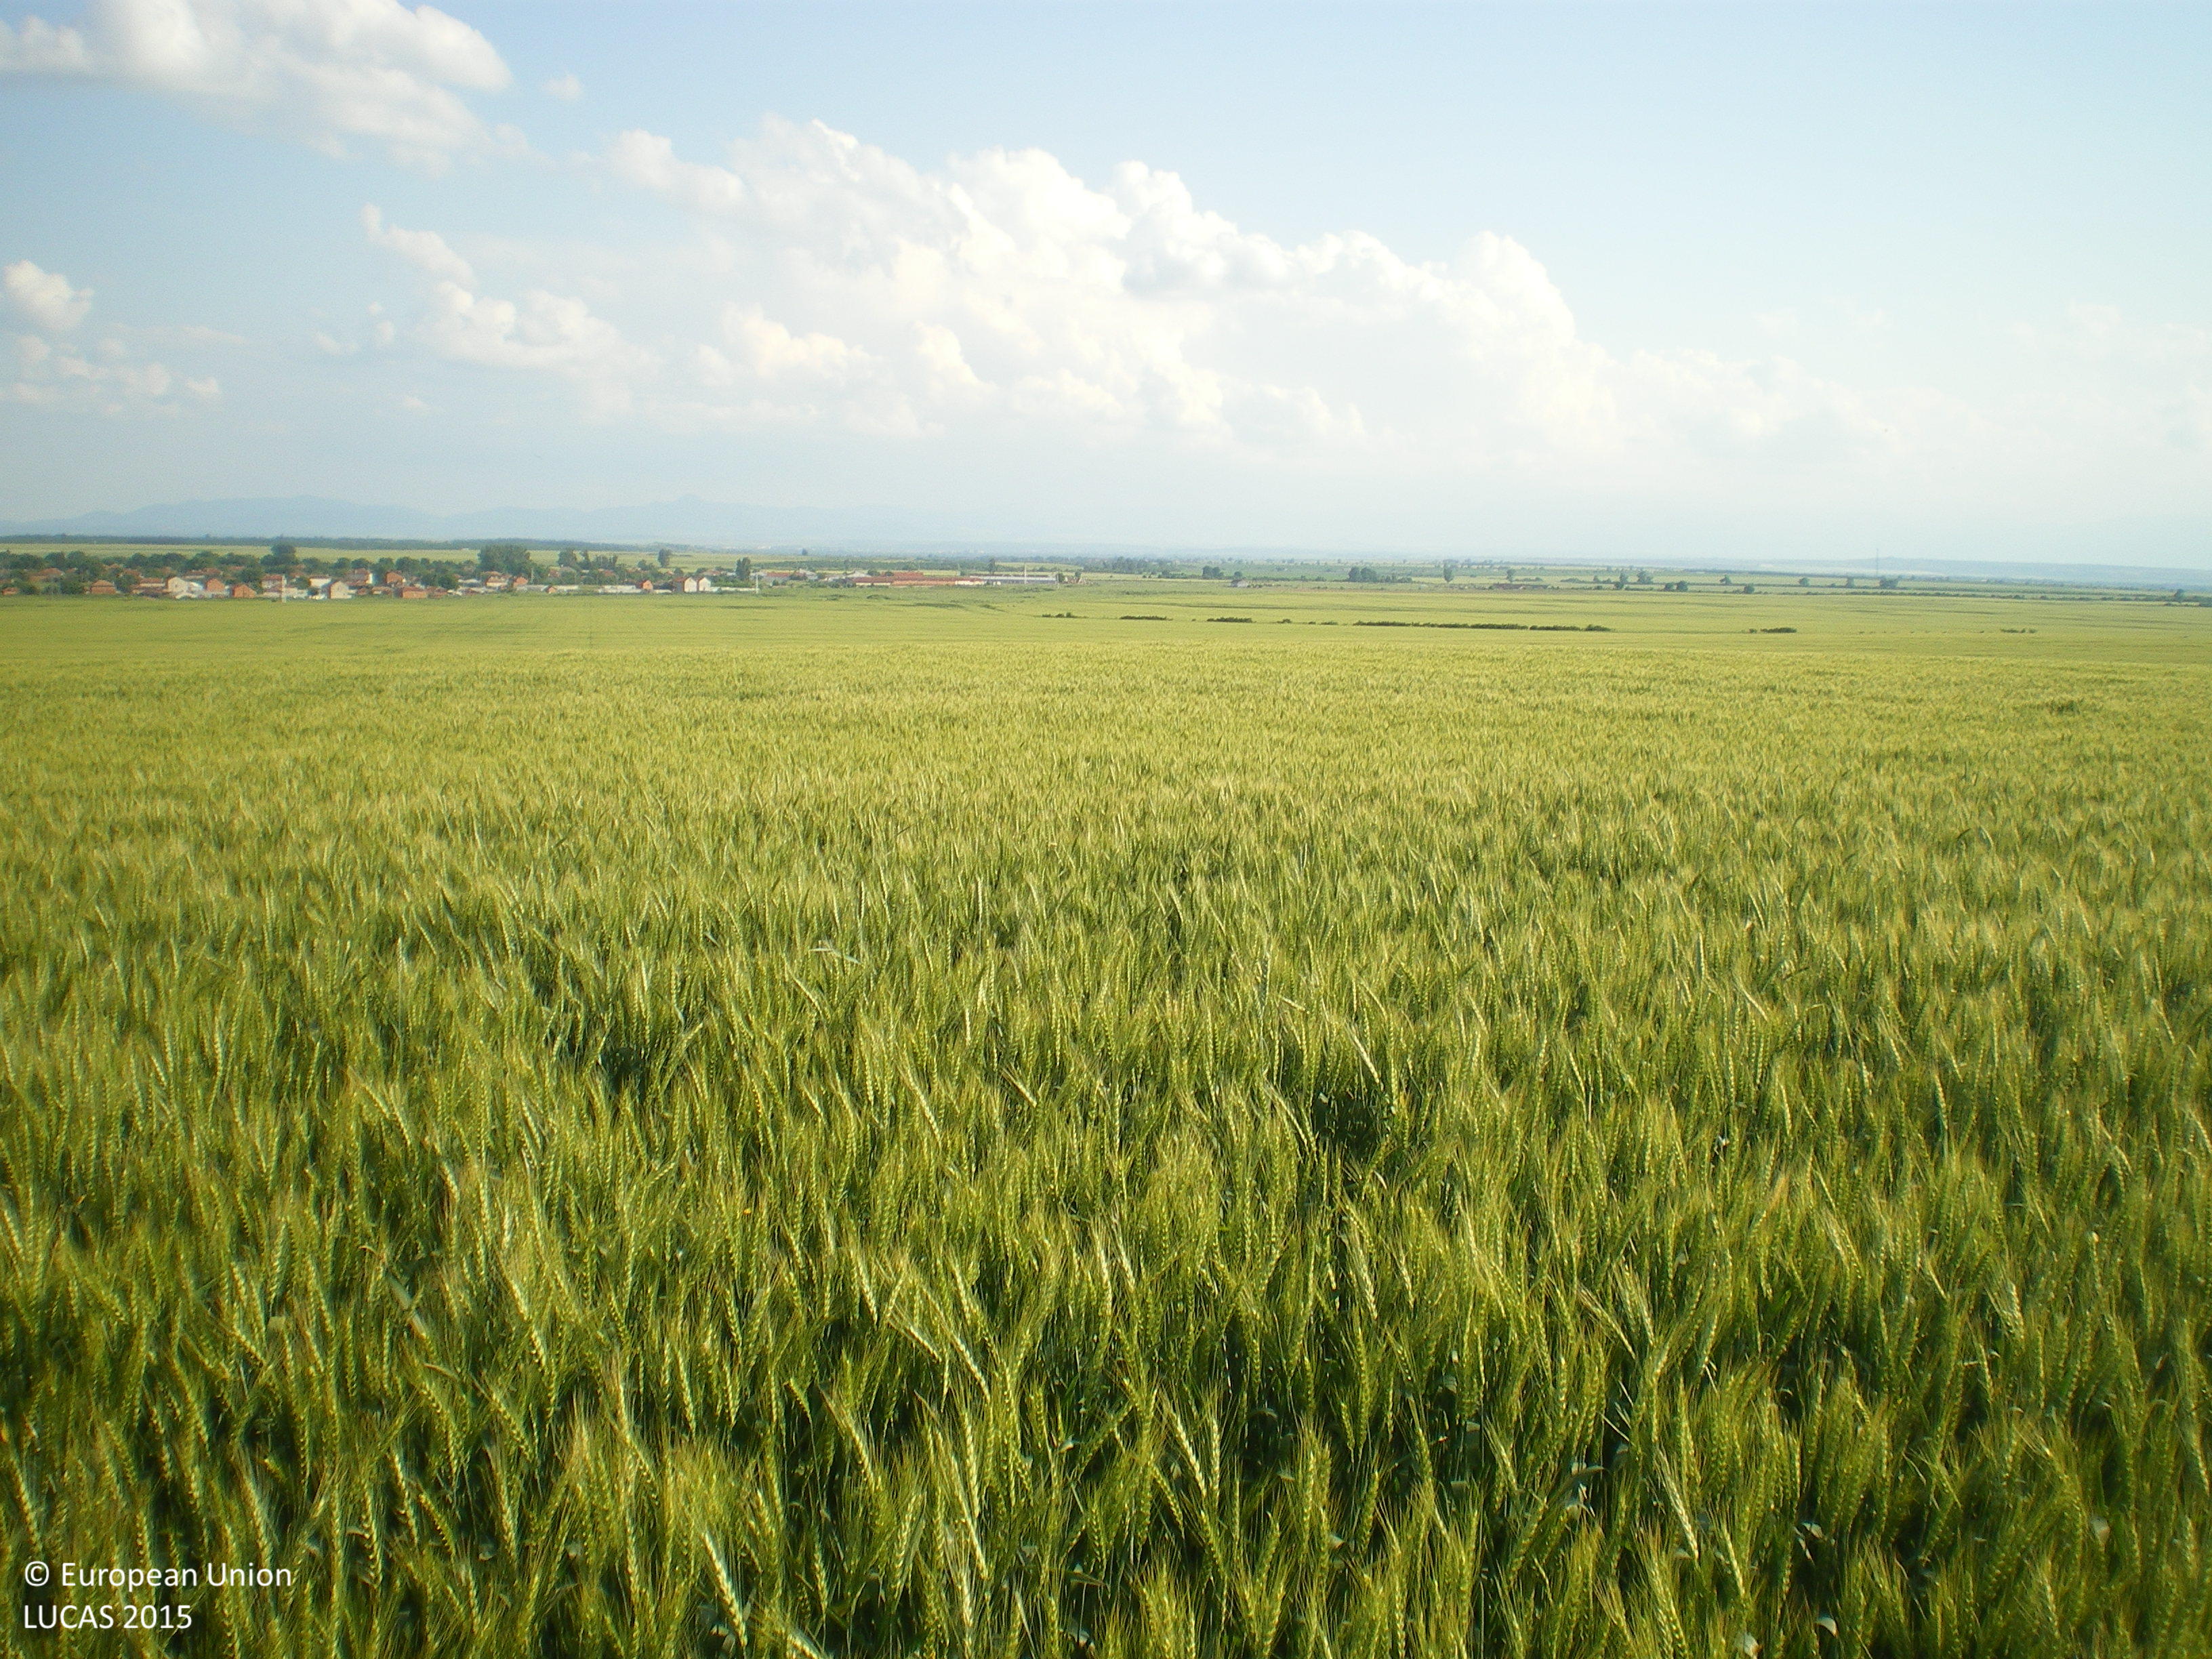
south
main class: Cropland
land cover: Durum wheat
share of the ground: > 75 %
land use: Agriculture (excluding fallow land and kitchen gardens)
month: May
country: BG
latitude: 42.2300
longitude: 25.2190
